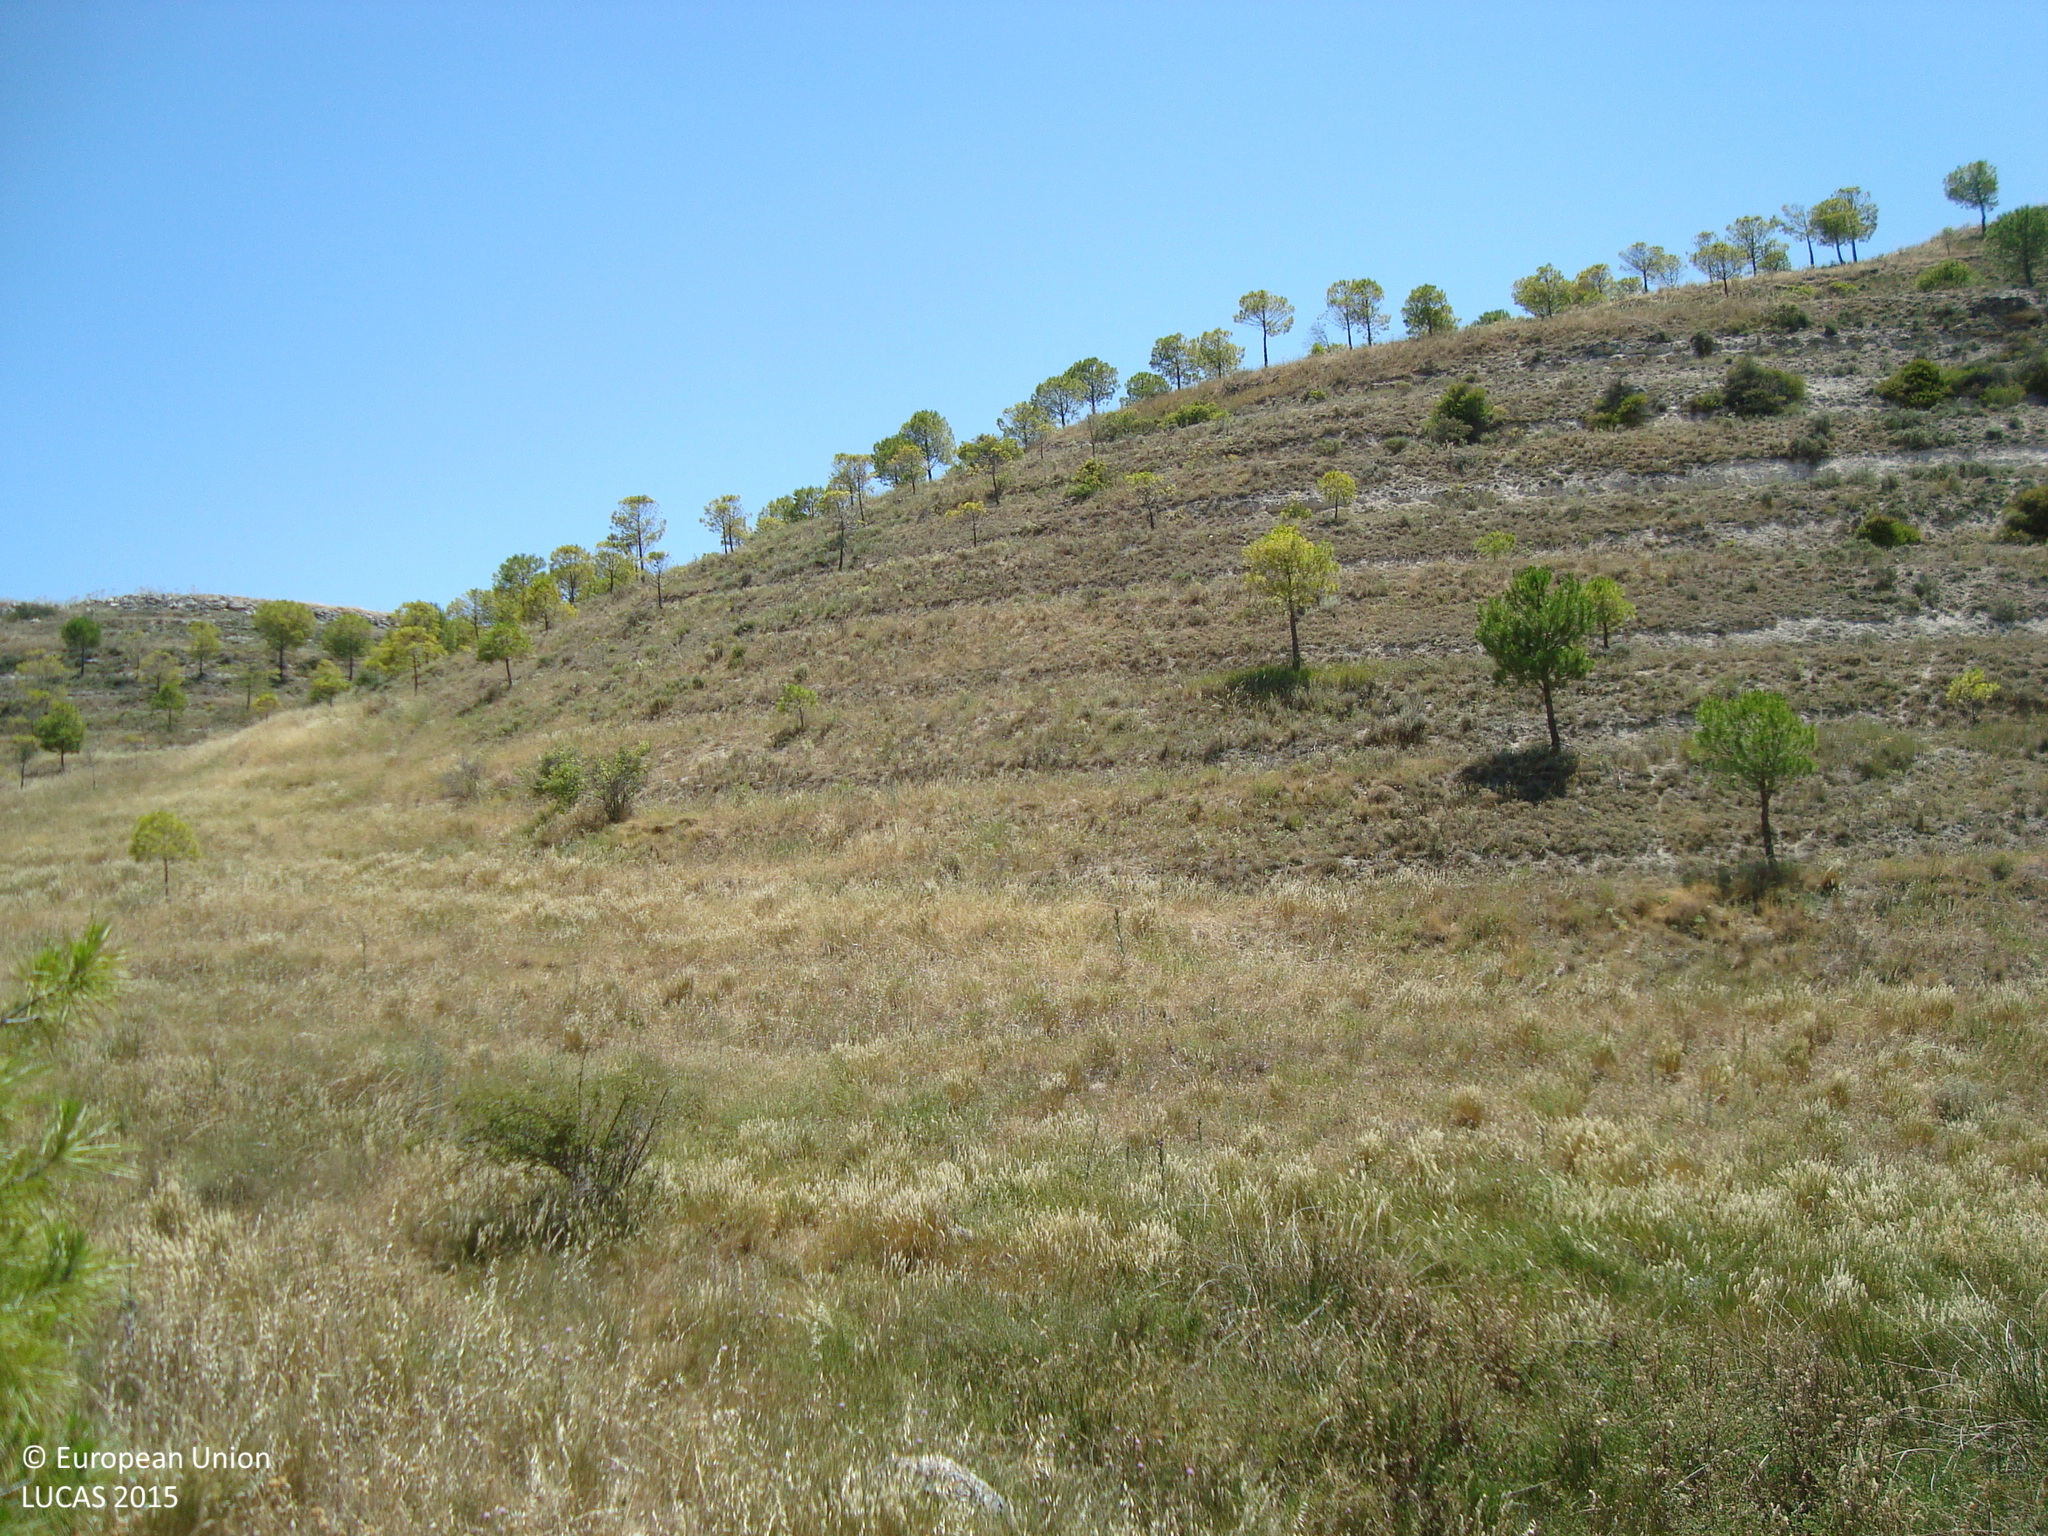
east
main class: Woodland
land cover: Pine dominated coniferous woodland
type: coniferous forest of the mediterranean region
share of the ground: 10 - 25 %
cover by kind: herbaceous plants 75 %, coniferous forest trees 15 %, shrubs 10 %
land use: Semi-natural and natural areas not in use
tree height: < 5 m
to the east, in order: Pine dominated coniferous woodland; Grassland with sparse tree/shrub cover; Pine dominated coniferous woodland; Shrubland with sparse tree cover; Common wheat
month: July
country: ES
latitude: 41.6590
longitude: -4.1216
